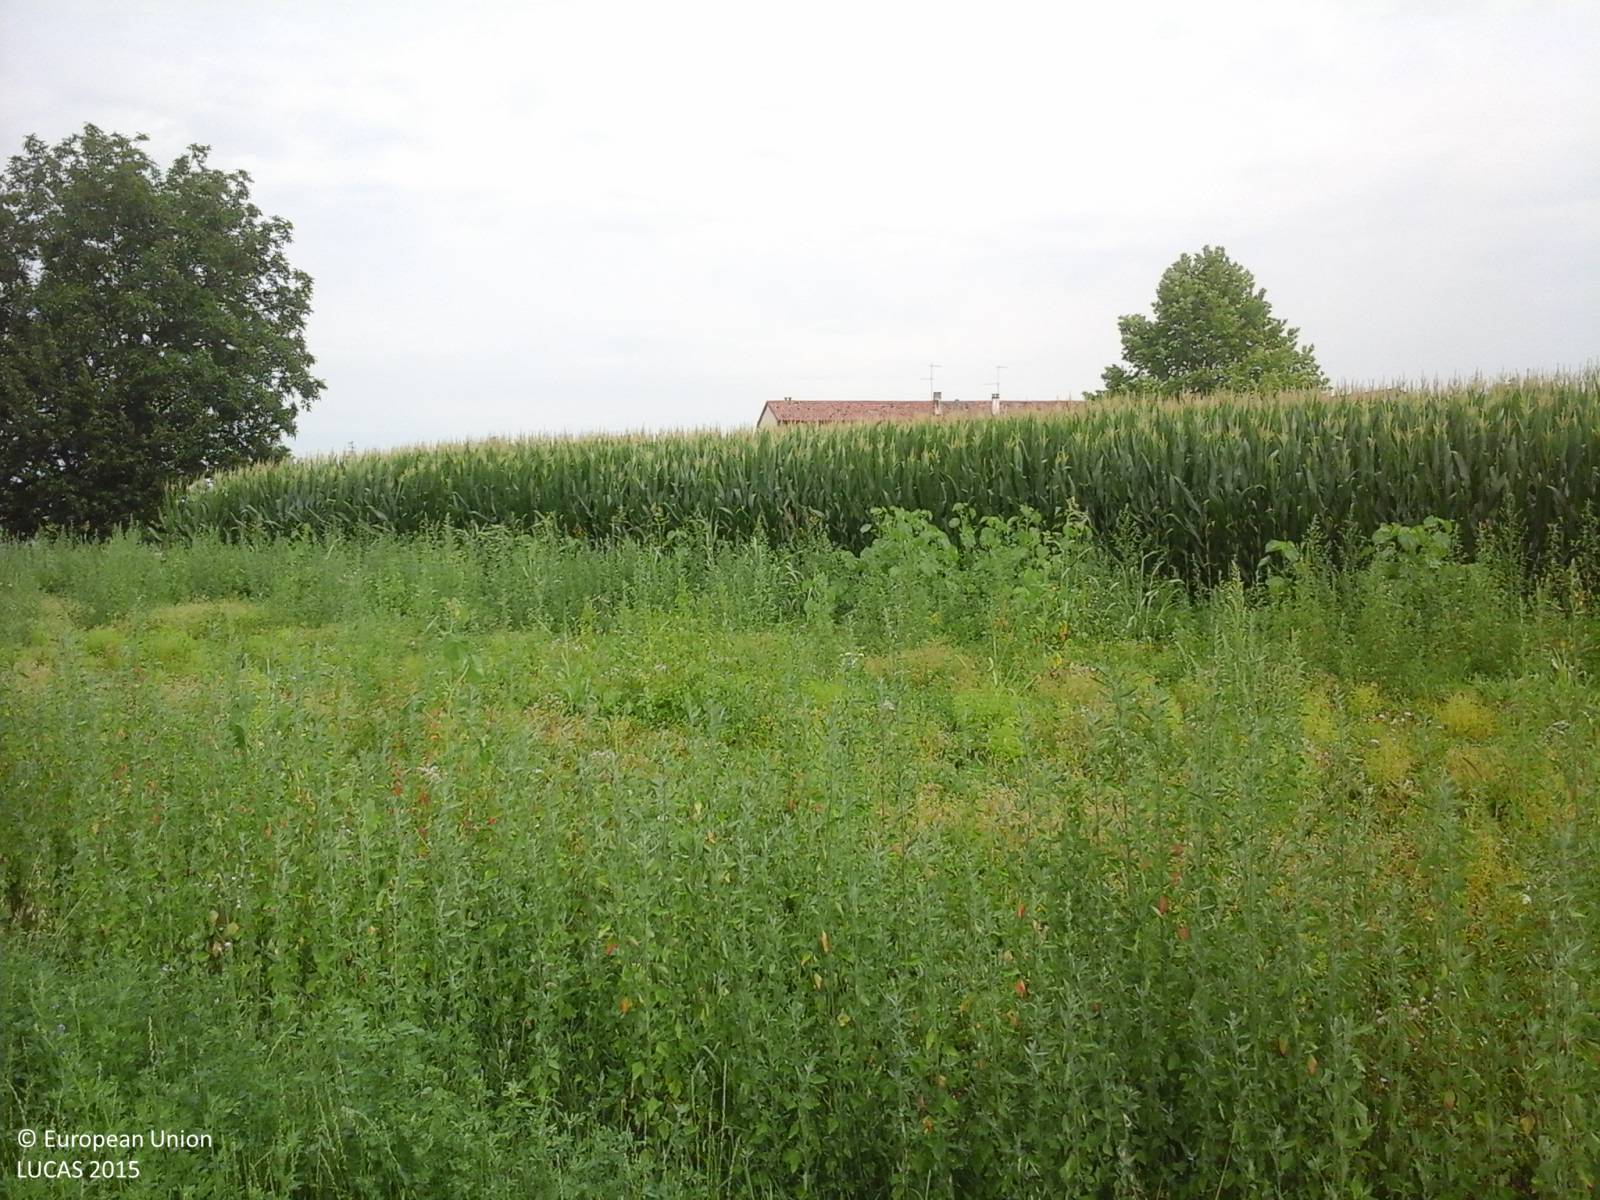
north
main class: Cropland
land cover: Lucerne
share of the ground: > 75 %
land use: Agriculture (excluding fallow land and kitchen gardens)
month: July
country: IT
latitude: 45.9471
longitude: 13.0537
